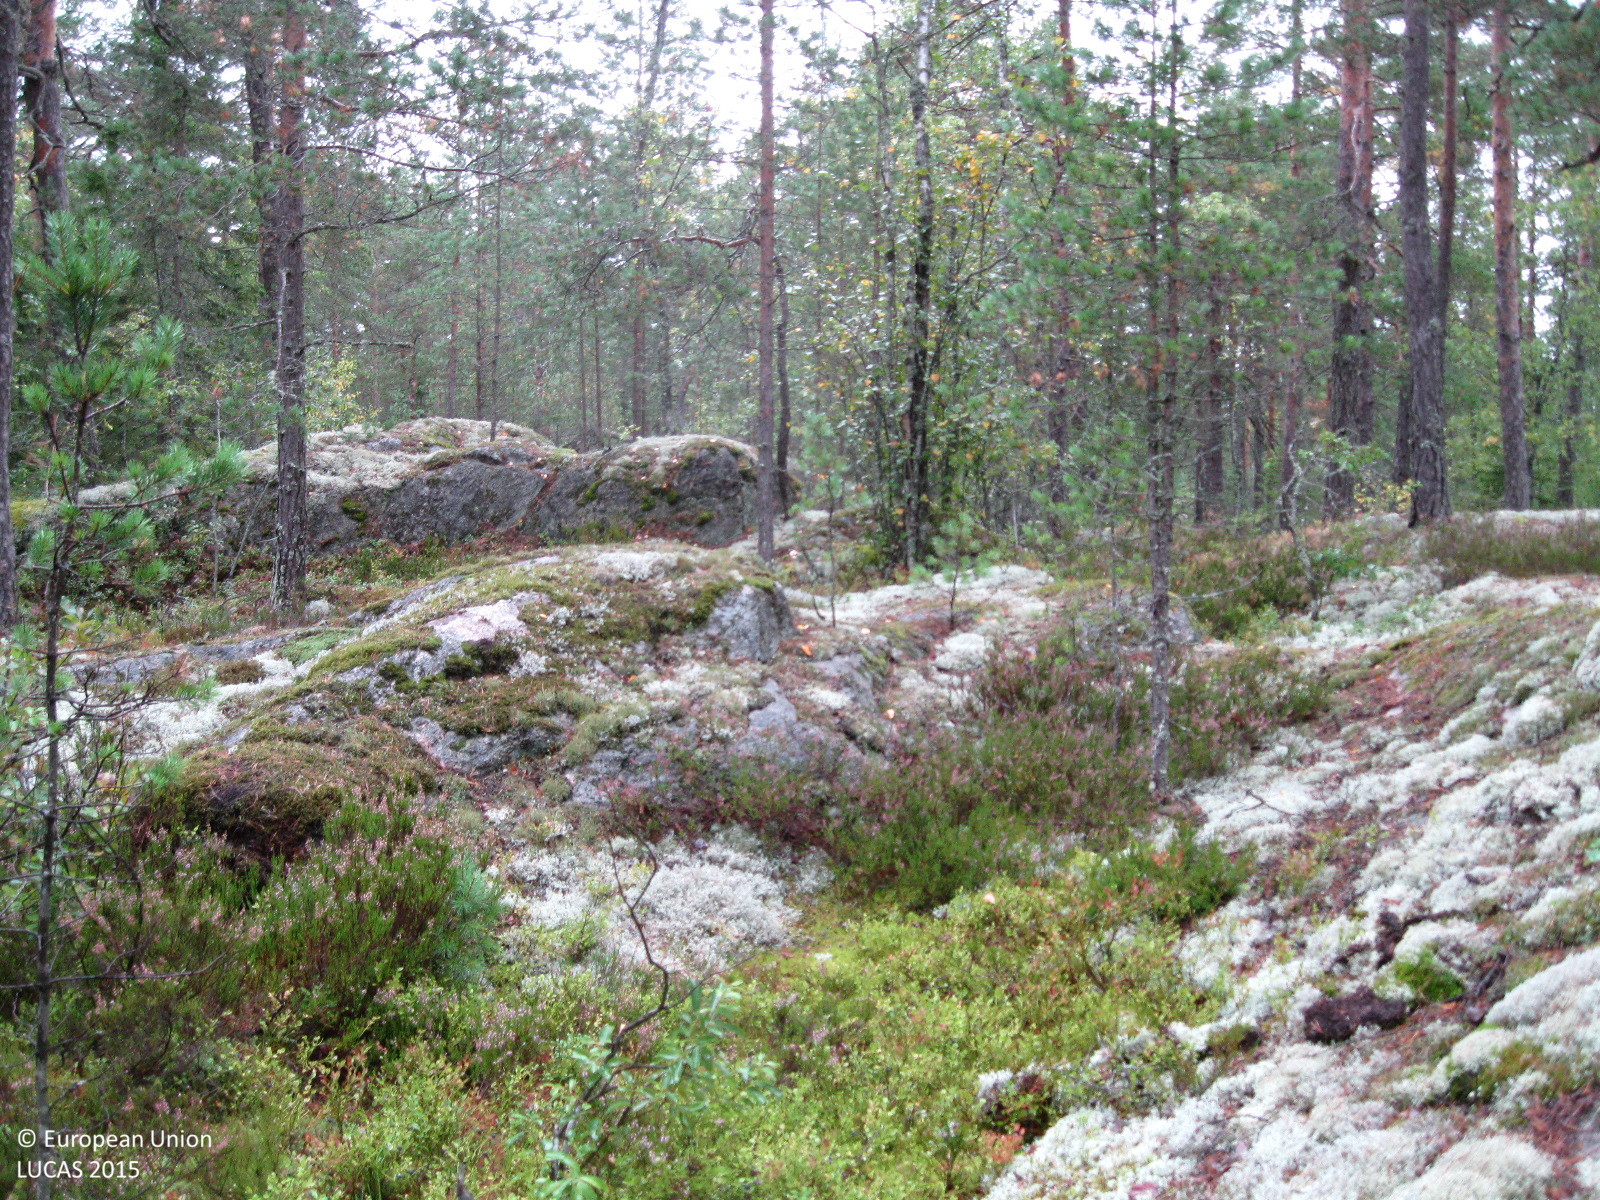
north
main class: Woodland
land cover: Pine dominated coniferous woodland
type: boreal forest
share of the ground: 25 - 50 %
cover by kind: shrubs 50 %, coniferous forest trees 25 %, herbaceous plants 20 %, lichens and mosses 5 %
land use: Forestry
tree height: > 5 m
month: September
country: FI
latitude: 60.2748
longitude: 24.6292
